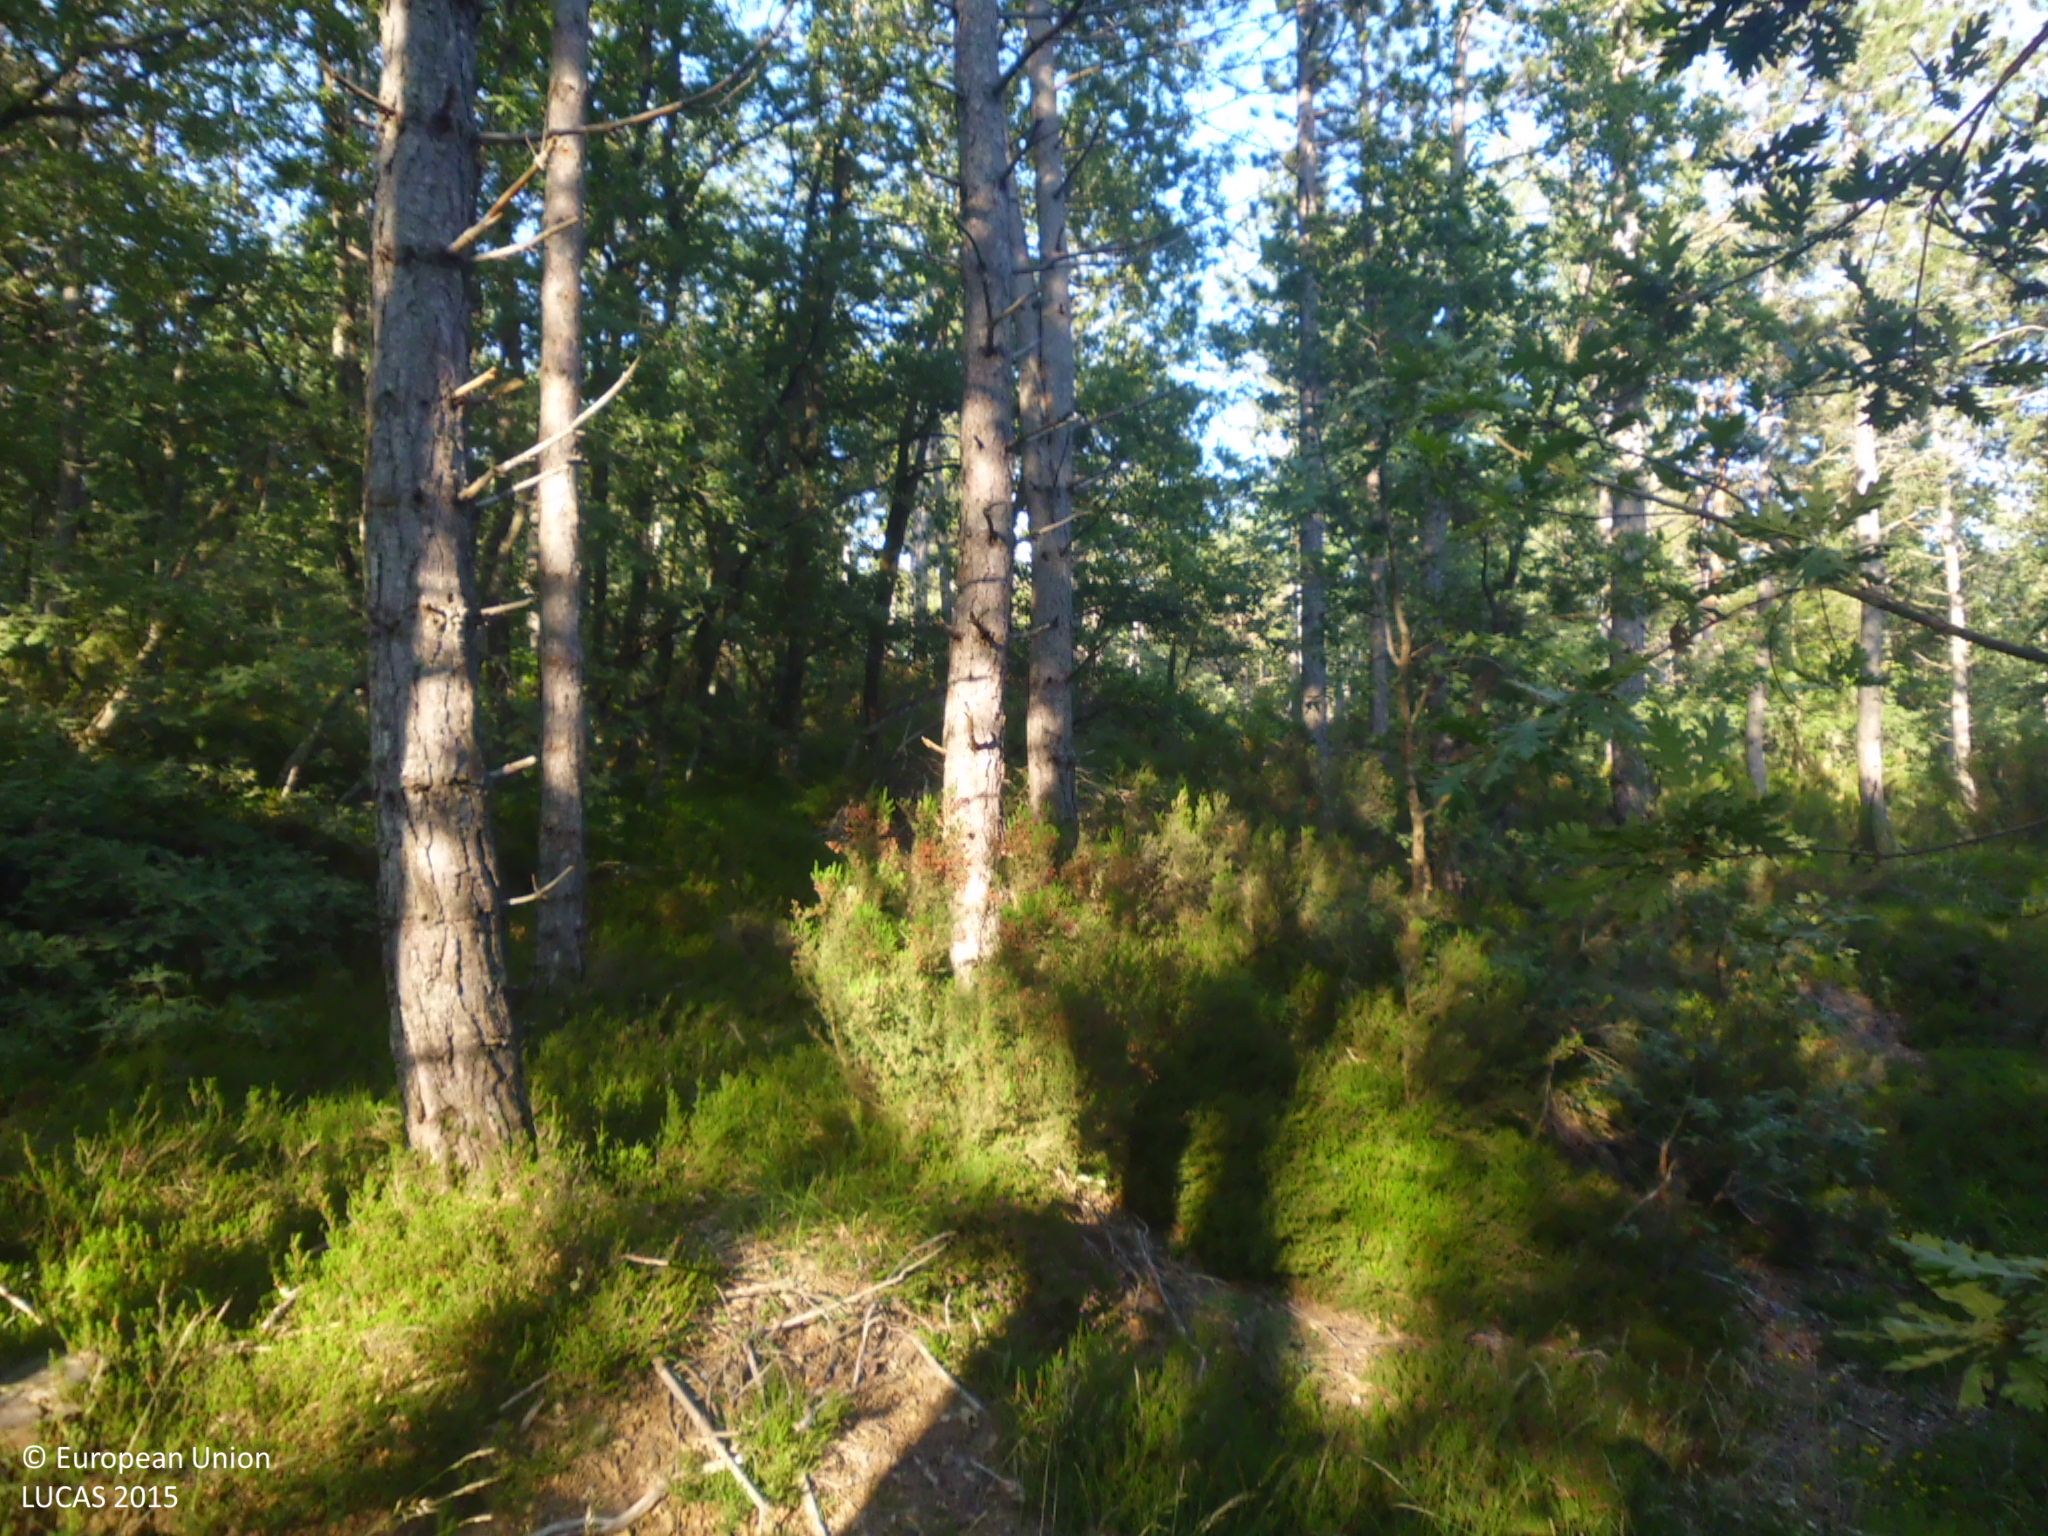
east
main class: Woodland
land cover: Pine dominated coniferous woodland
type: coniferous forest of the mediterranean region
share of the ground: > 75 %
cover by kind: coniferous forest trees 65 %, herbaceous plants 20 %, broadleaved forest trees 10 %, consolidated bare surface 5 %
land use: Forestry
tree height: > 5 m
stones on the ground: 25 - 50 %
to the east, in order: Pine dominated coniferous woodland
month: June
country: ES
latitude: 42.3478
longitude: -3.3724
